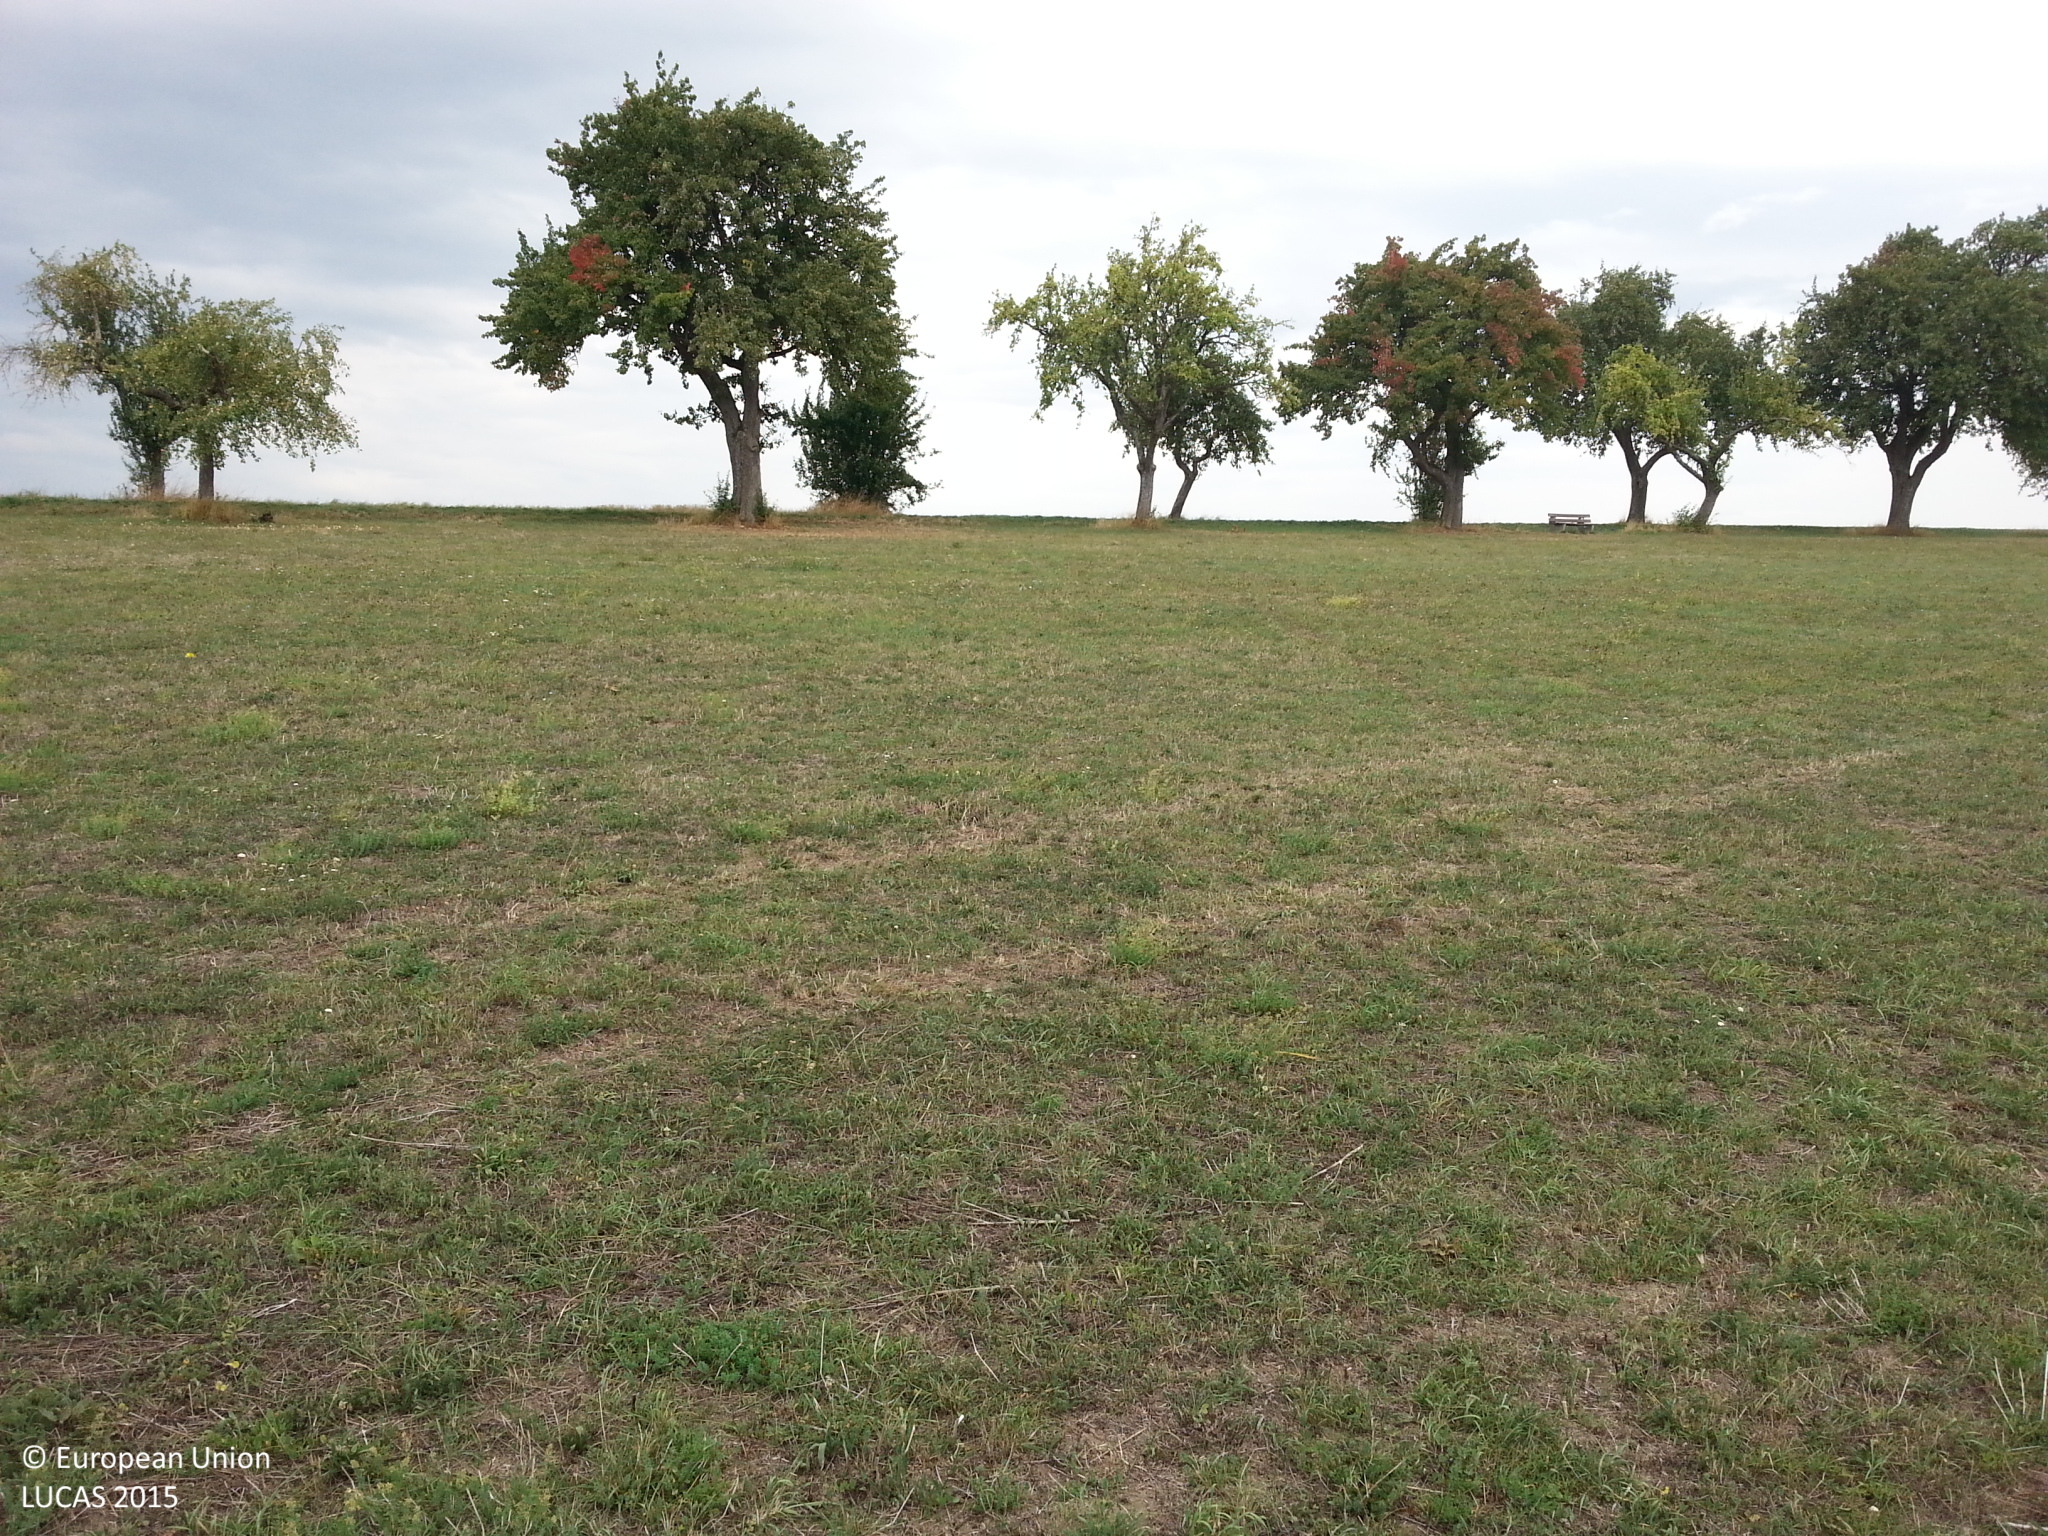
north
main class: Grassland
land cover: Grassland without tree/shrub cover
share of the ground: > 75 %
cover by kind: herbaceous plants 90 %, unconsolidated bare surface 10 %
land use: Agriculture (excluding fallow land and kitchen gardens)
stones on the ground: < 10 %
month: September
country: DE
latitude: 49.2670
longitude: 9.9588
